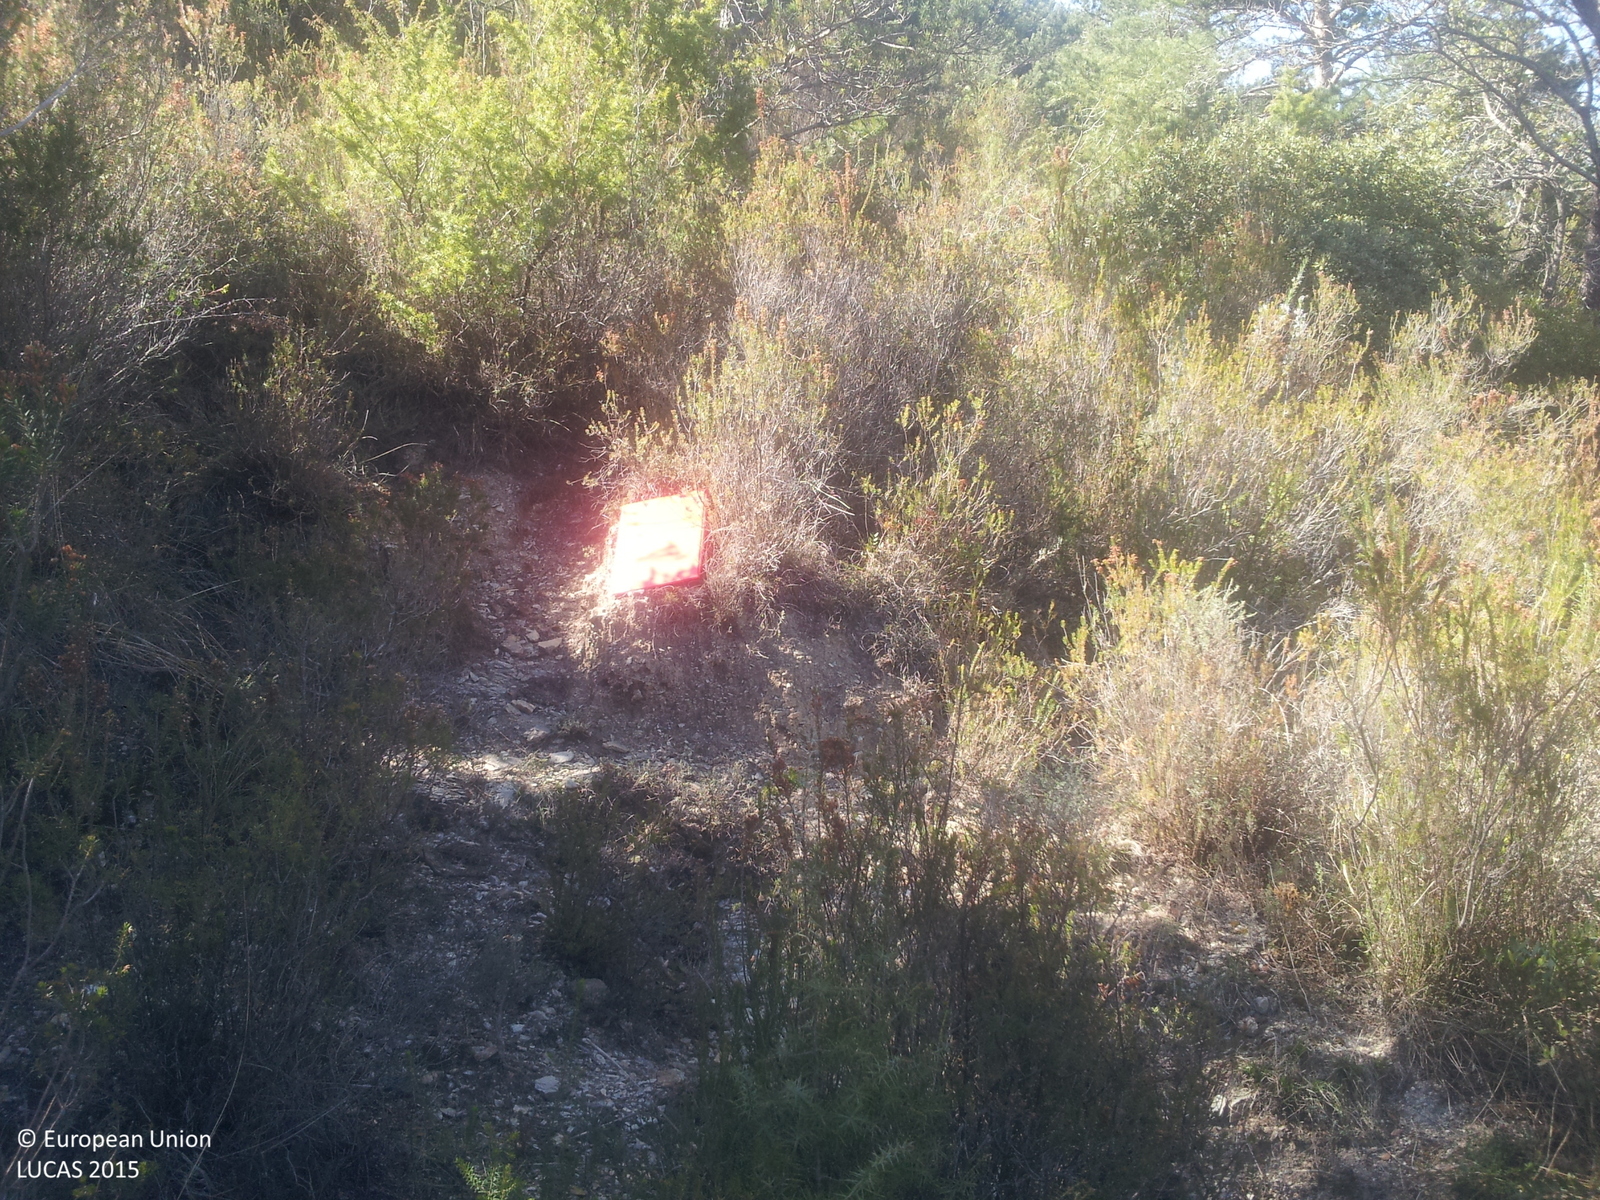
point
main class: Woodland
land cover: Pine dominated coniferous woodland
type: coniferous forest of the mediterranean region
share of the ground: 50 - 75 %
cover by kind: coniferous forest trees 70 %, shrubs 30 %
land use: Forestry
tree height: > 5 m
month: April
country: ES
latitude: 42.2514
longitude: 2.5352
